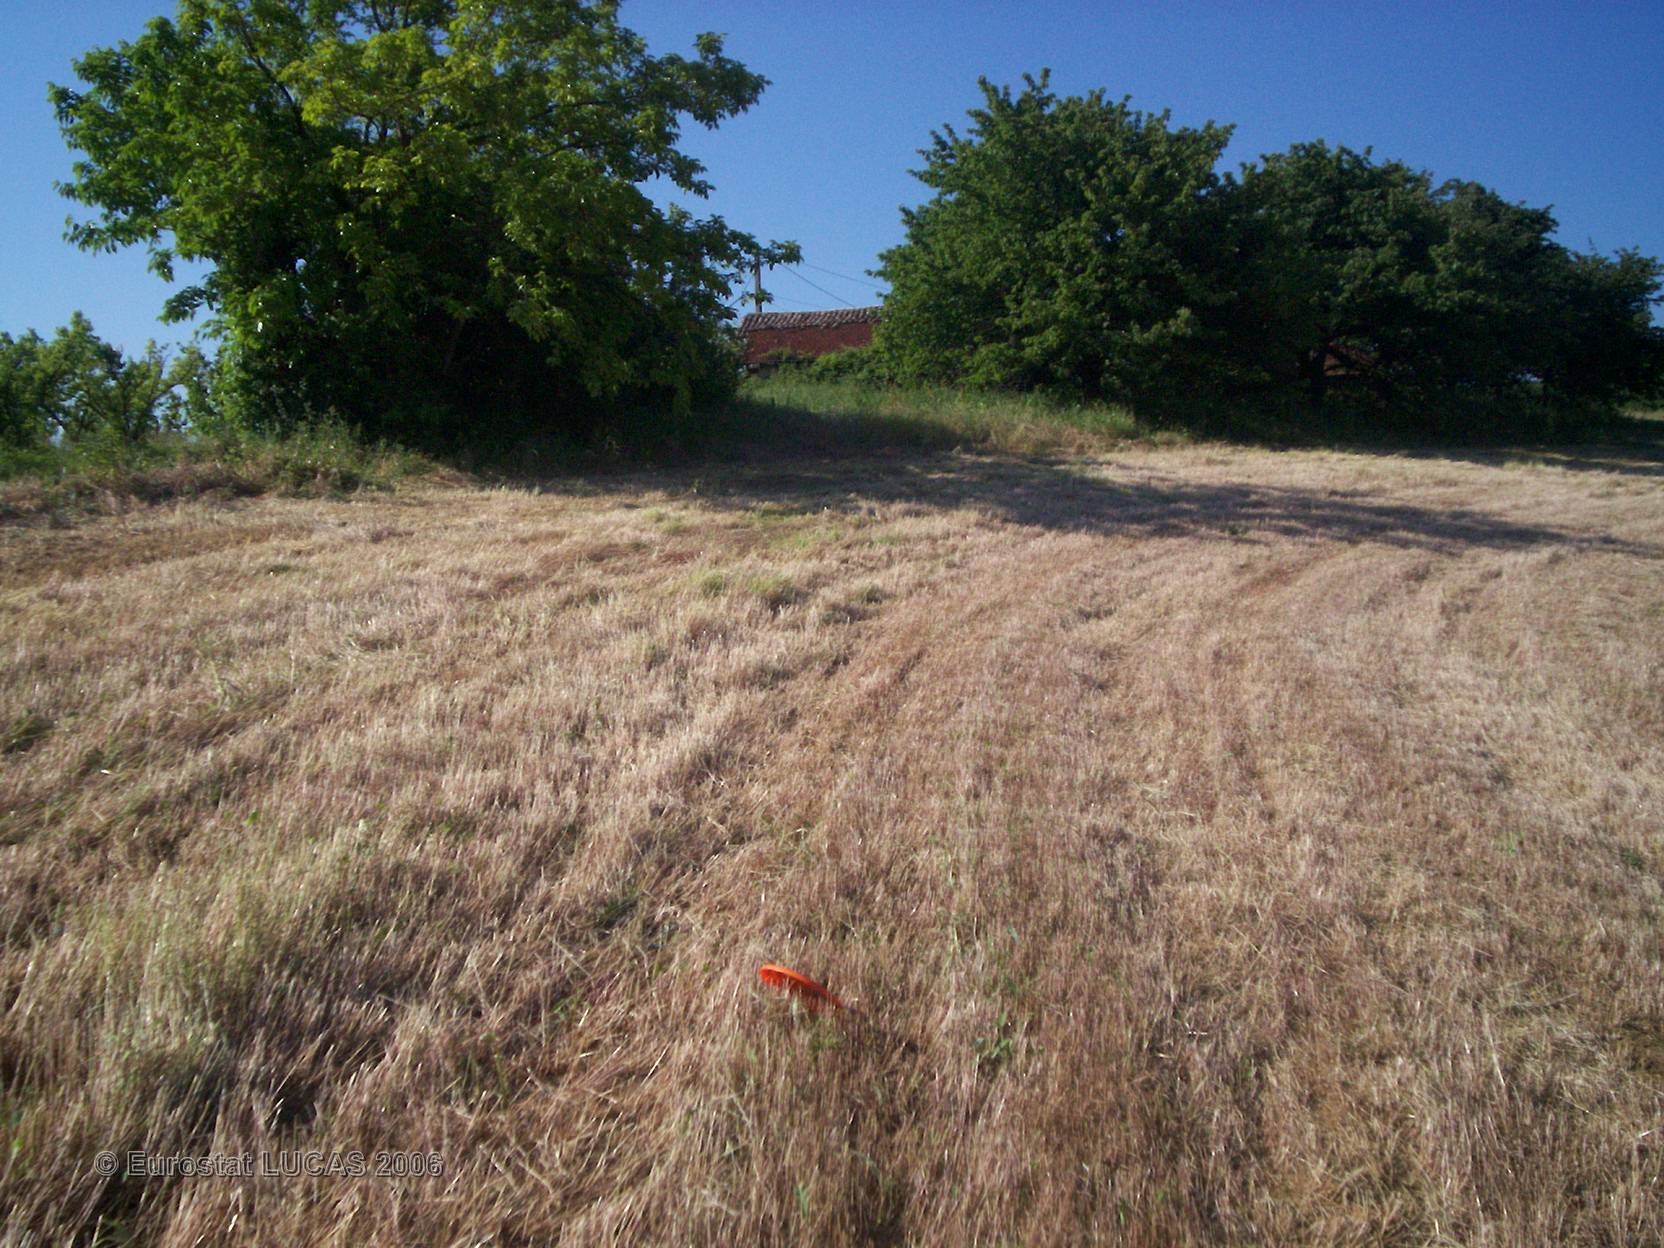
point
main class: Grassland
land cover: Grassland without tree/shrub cover
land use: Agriculture (excluding fallow land and kitchen gardens)
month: June
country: FR
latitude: 45.1275
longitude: 4.8814
